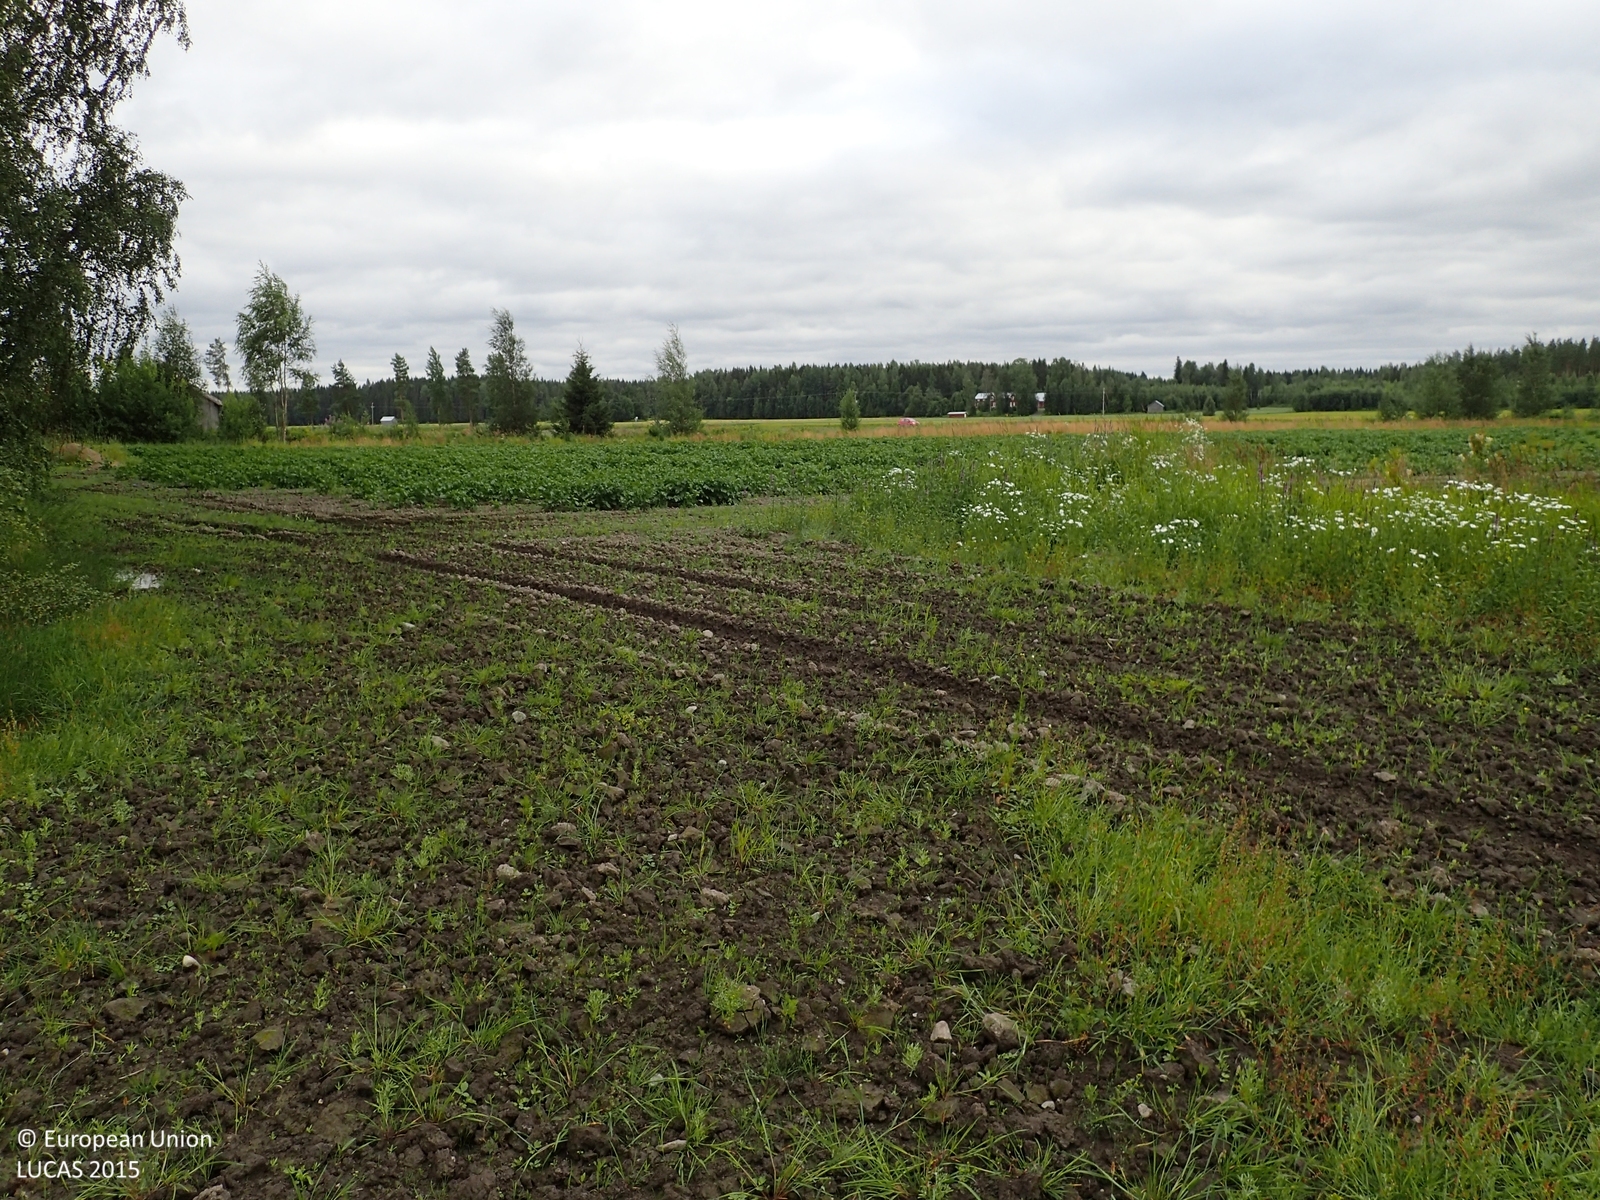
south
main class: Grassland
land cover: Spontaneously vegetated surfaces
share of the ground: 50 - 75 %
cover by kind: herbaceous plants 70 %, unconsolidated bare surface 30 %
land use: Fallow land
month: August
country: FI
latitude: 62.9400
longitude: 22.1652
